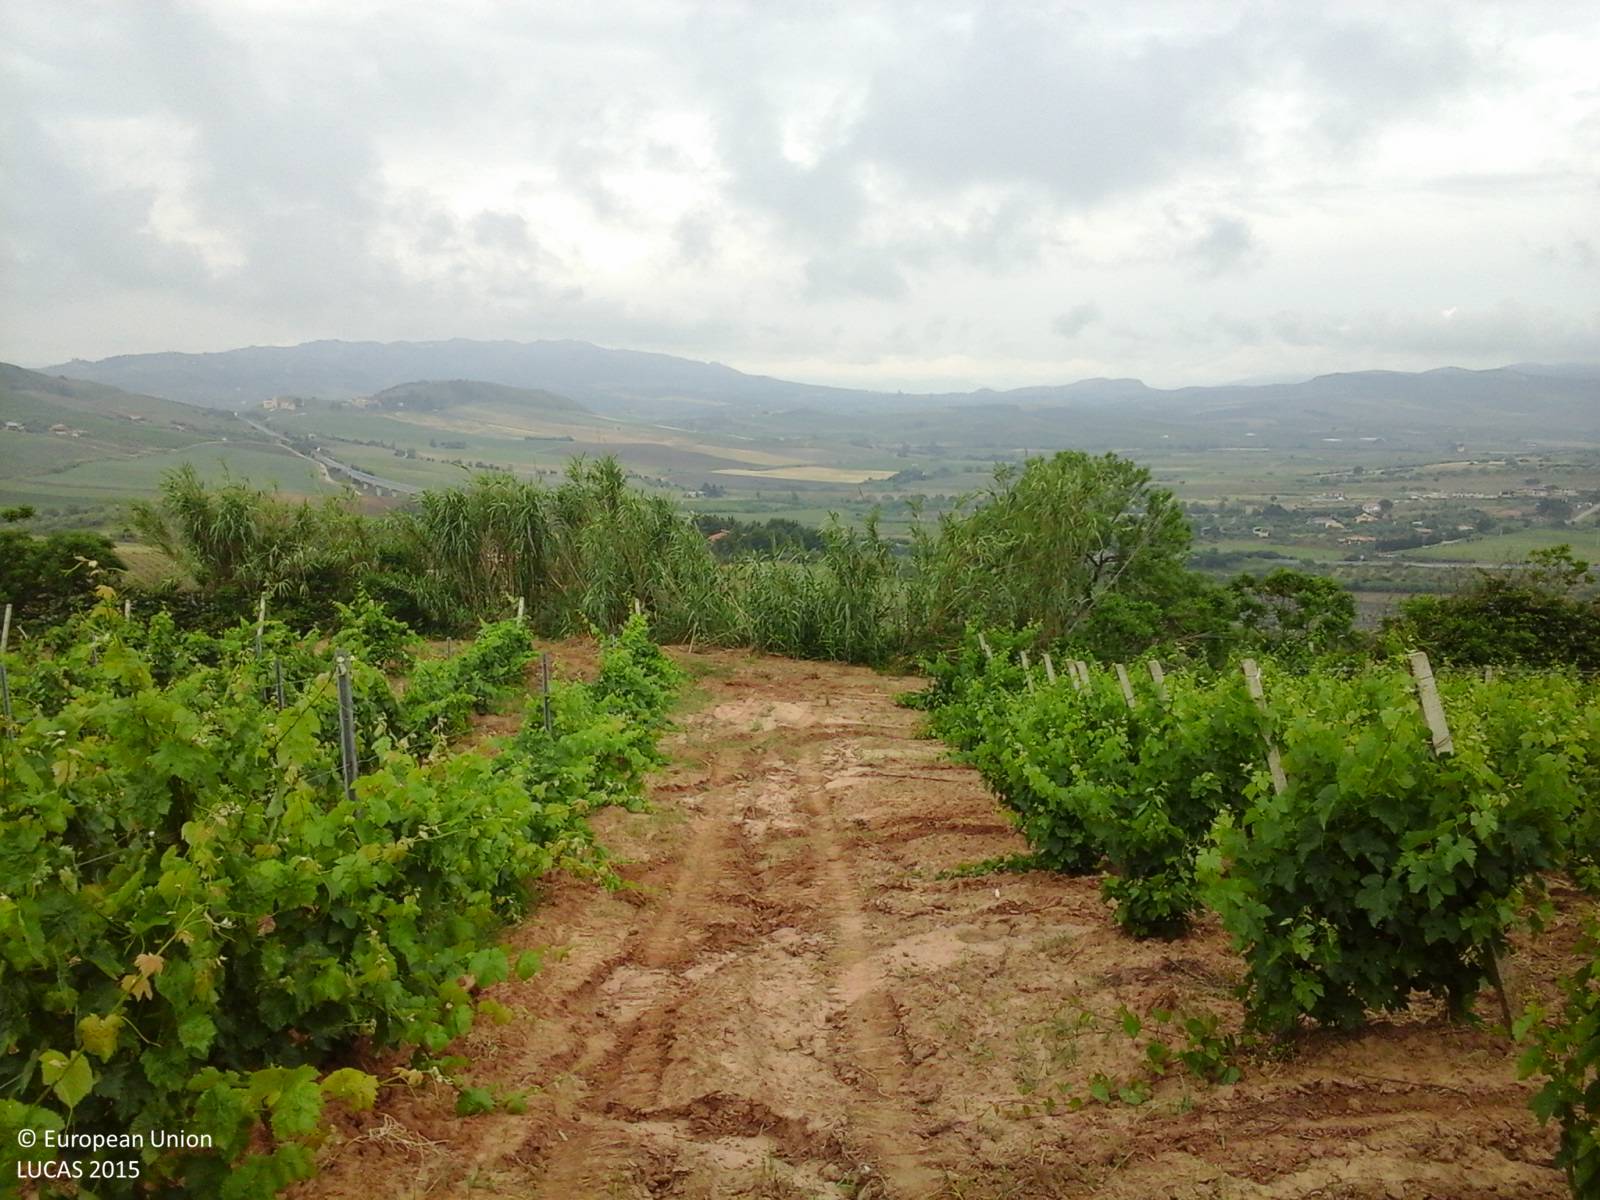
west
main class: Cropland
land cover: Vineyards
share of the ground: 50 - 75 %
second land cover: Other bare soil
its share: > 75 %
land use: Agriculture (excluding fallow land and kitchen gardens)
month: May
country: IT
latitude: 37.9307
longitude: 13.1741
